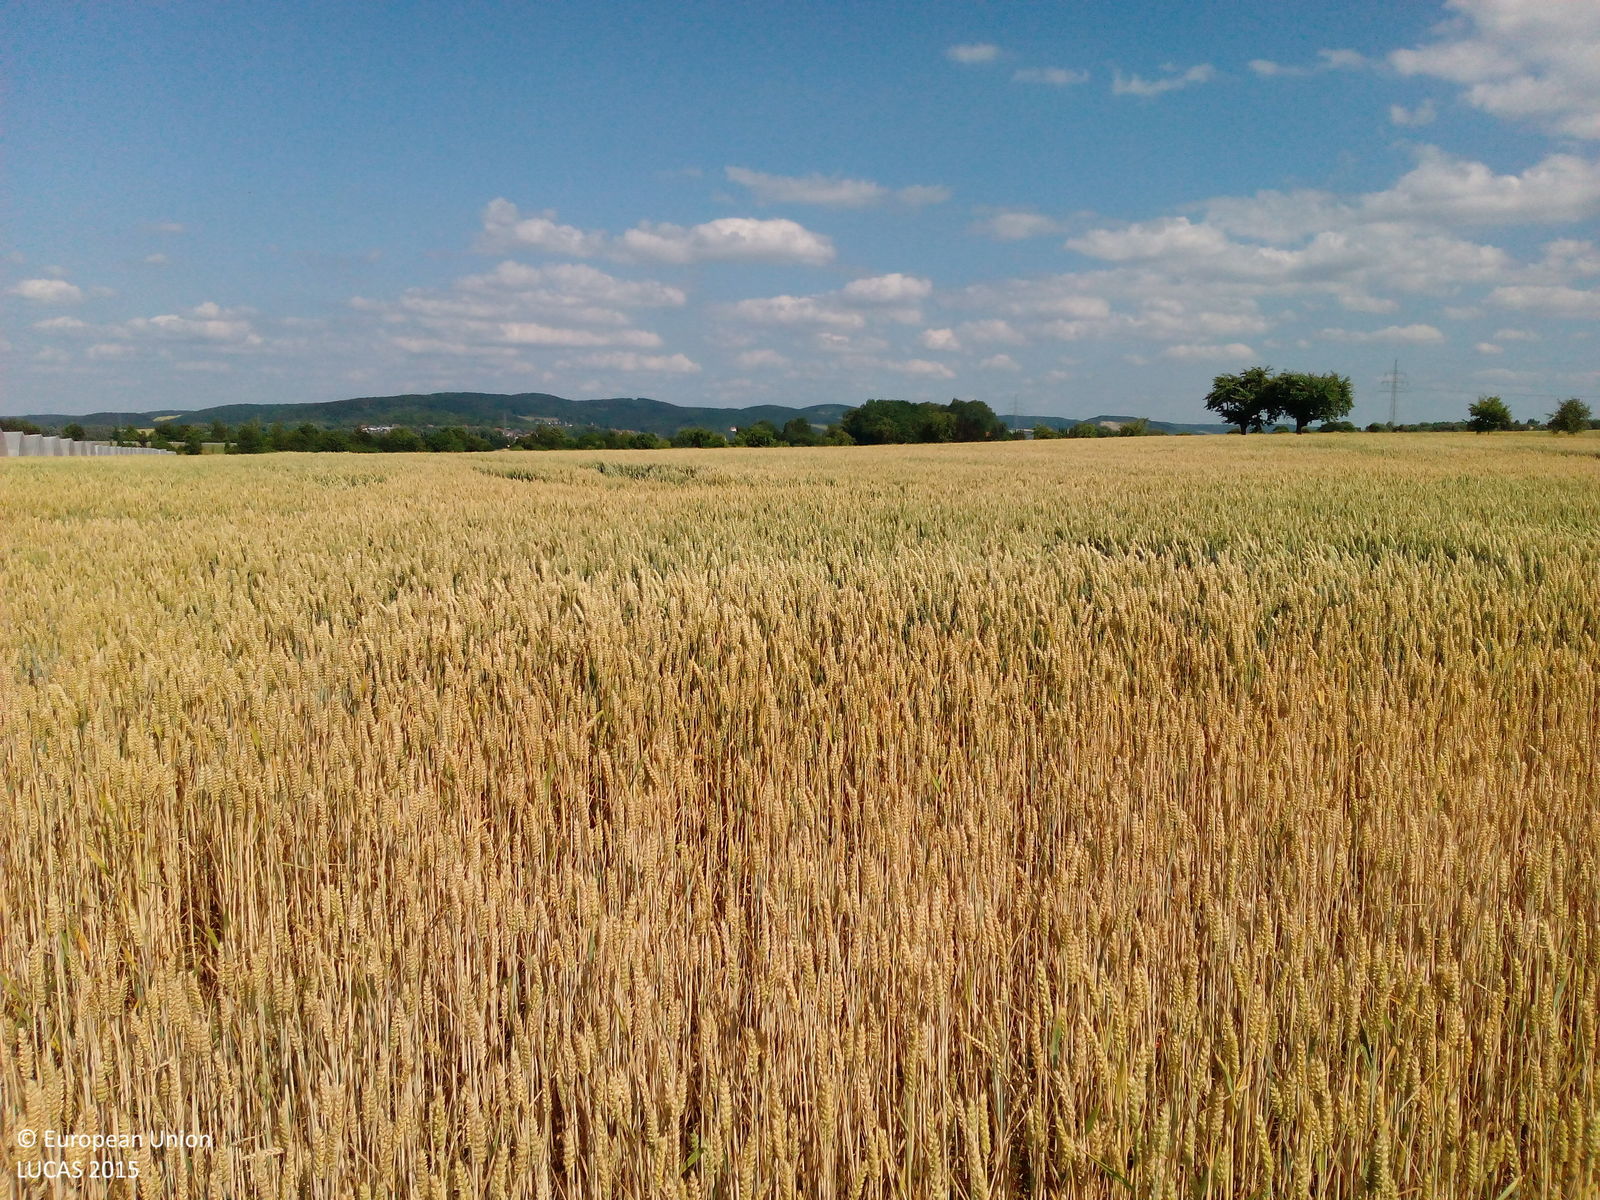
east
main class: Cropland
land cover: Common wheat
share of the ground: > 75 %
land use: Agriculture (excluding fallow land and kitchen gardens)
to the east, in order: Common wheat
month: July
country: DE
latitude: 51.8022
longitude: 9.8695
